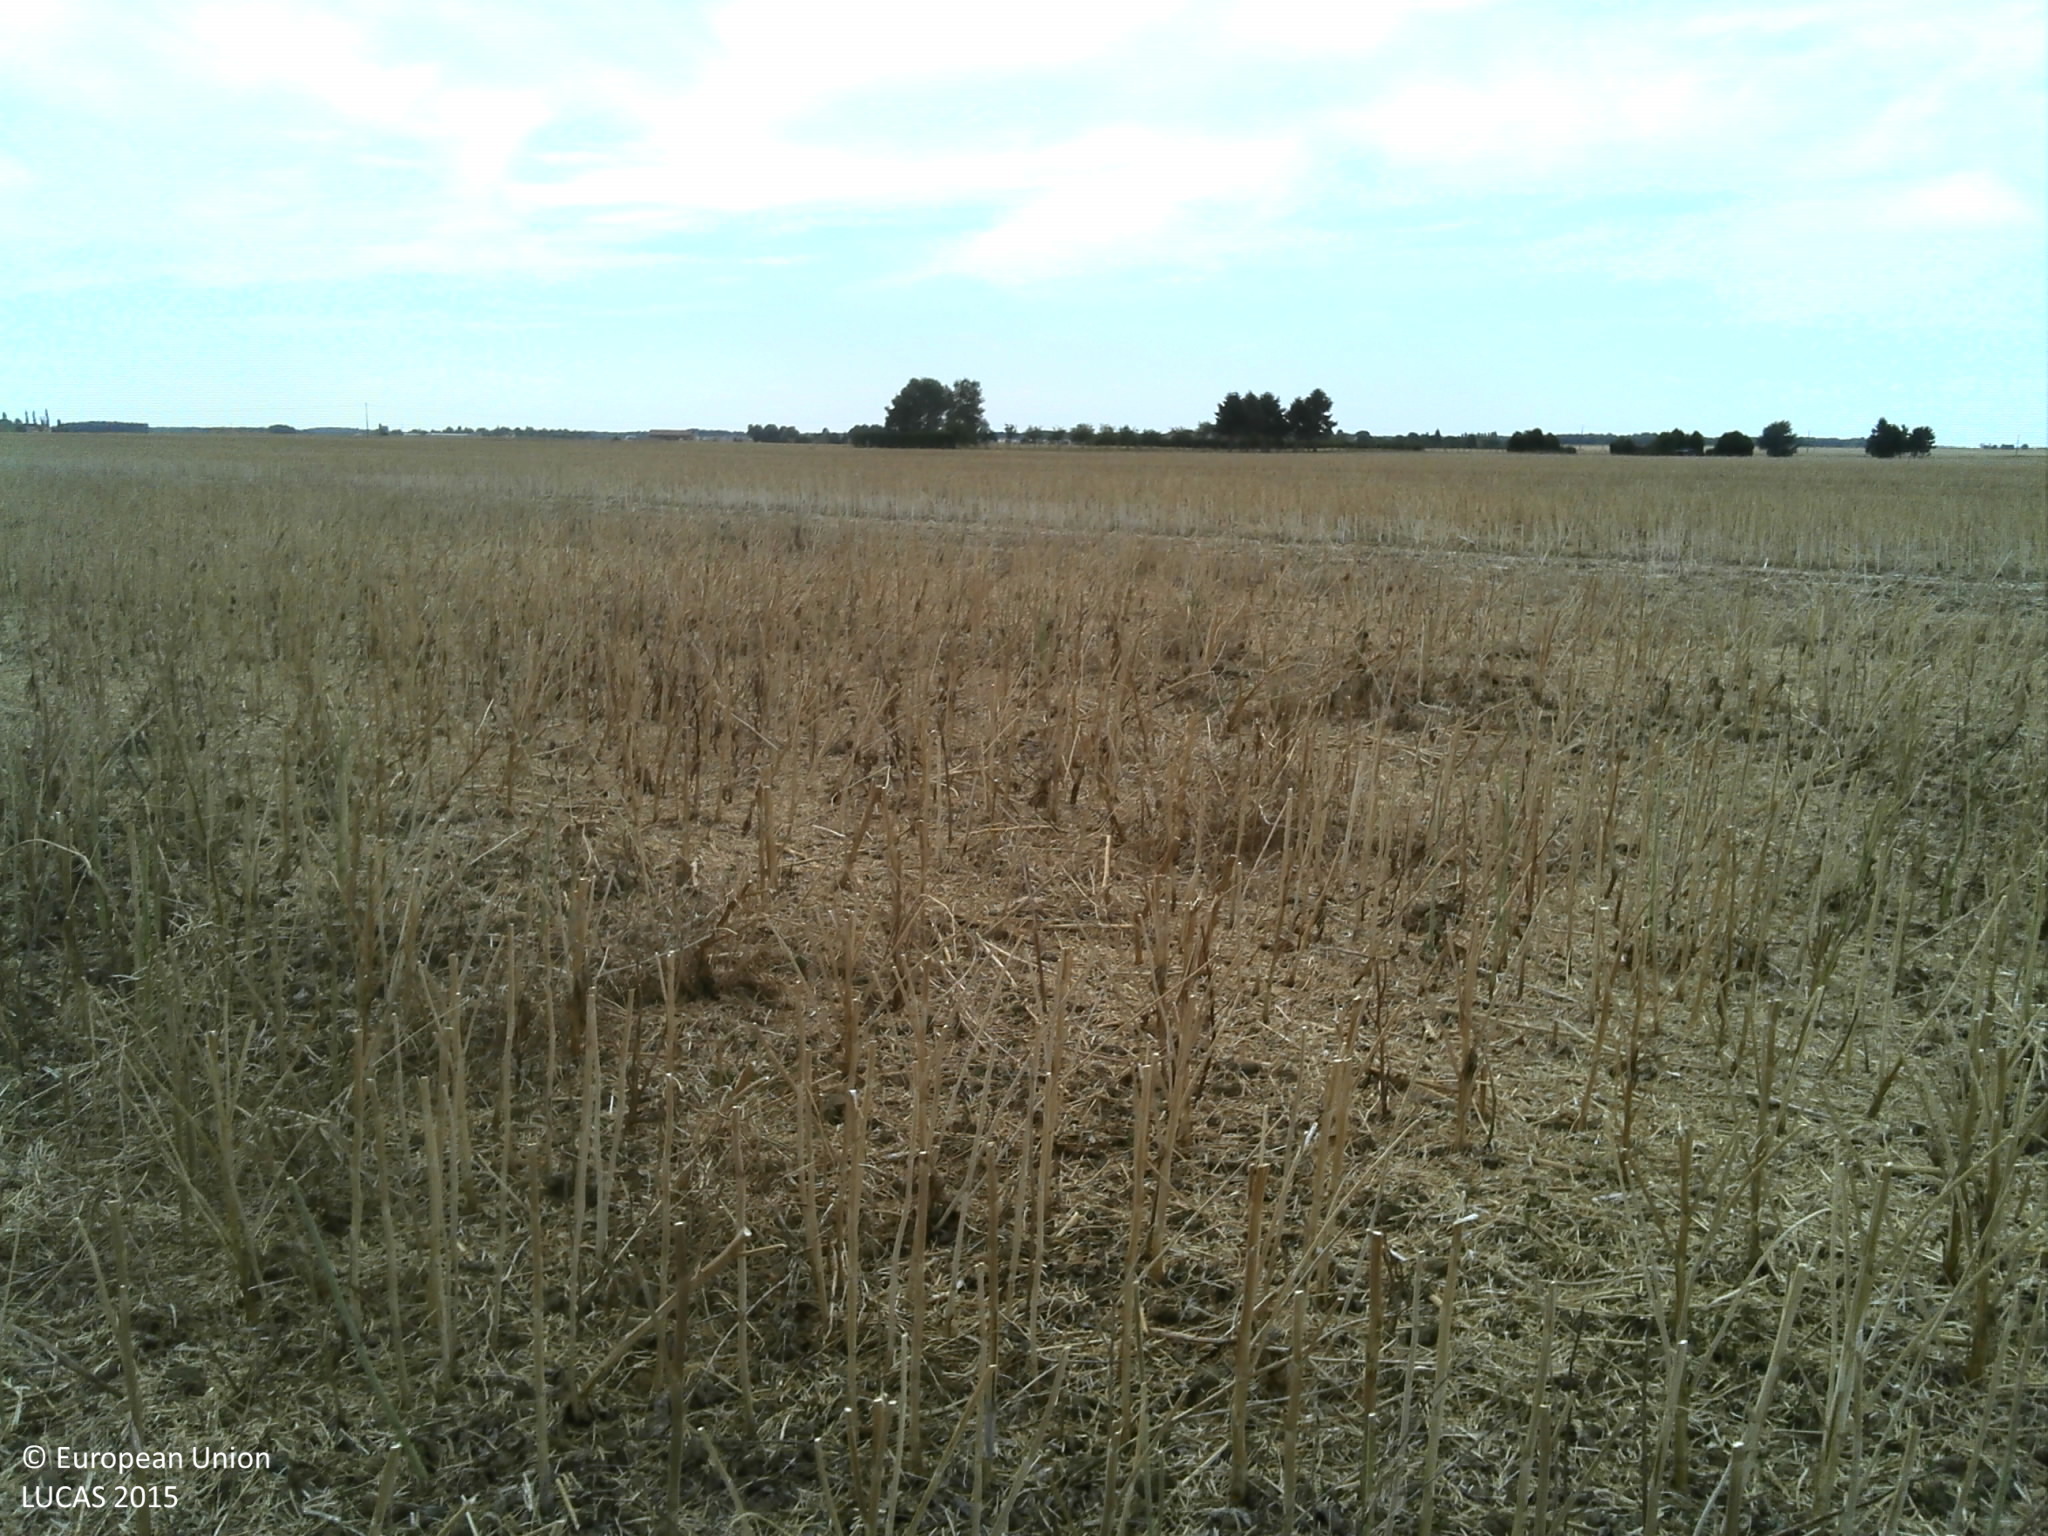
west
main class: Cropland
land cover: Rape and turnip rape
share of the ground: 25 - 50 %
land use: Agriculture (excluding fallow land and kitchen gardens)
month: August
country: FR
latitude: 48.5916
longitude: 1.8641
